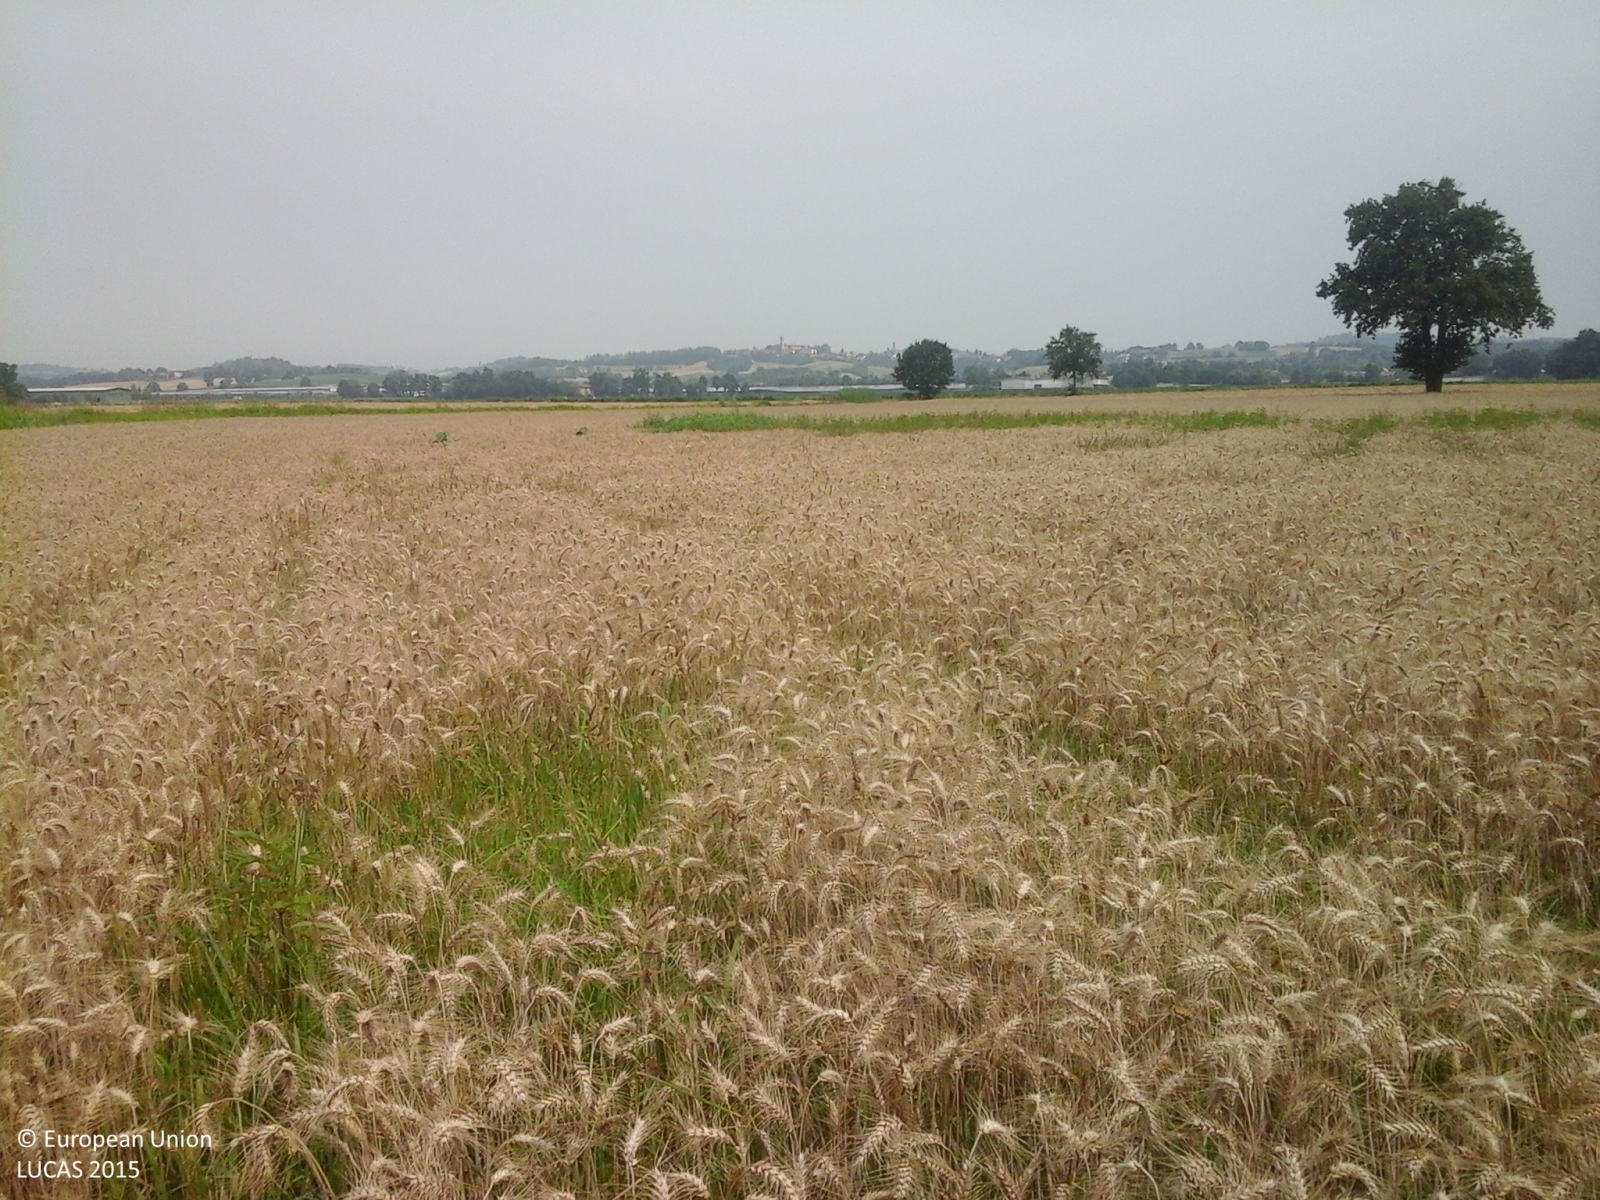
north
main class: Cropland
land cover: Common wheat
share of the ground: > 75 %
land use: Agriculture (excluding fallow land and kitchen gardens)
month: June
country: IT
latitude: 44.9539
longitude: 8.5704
